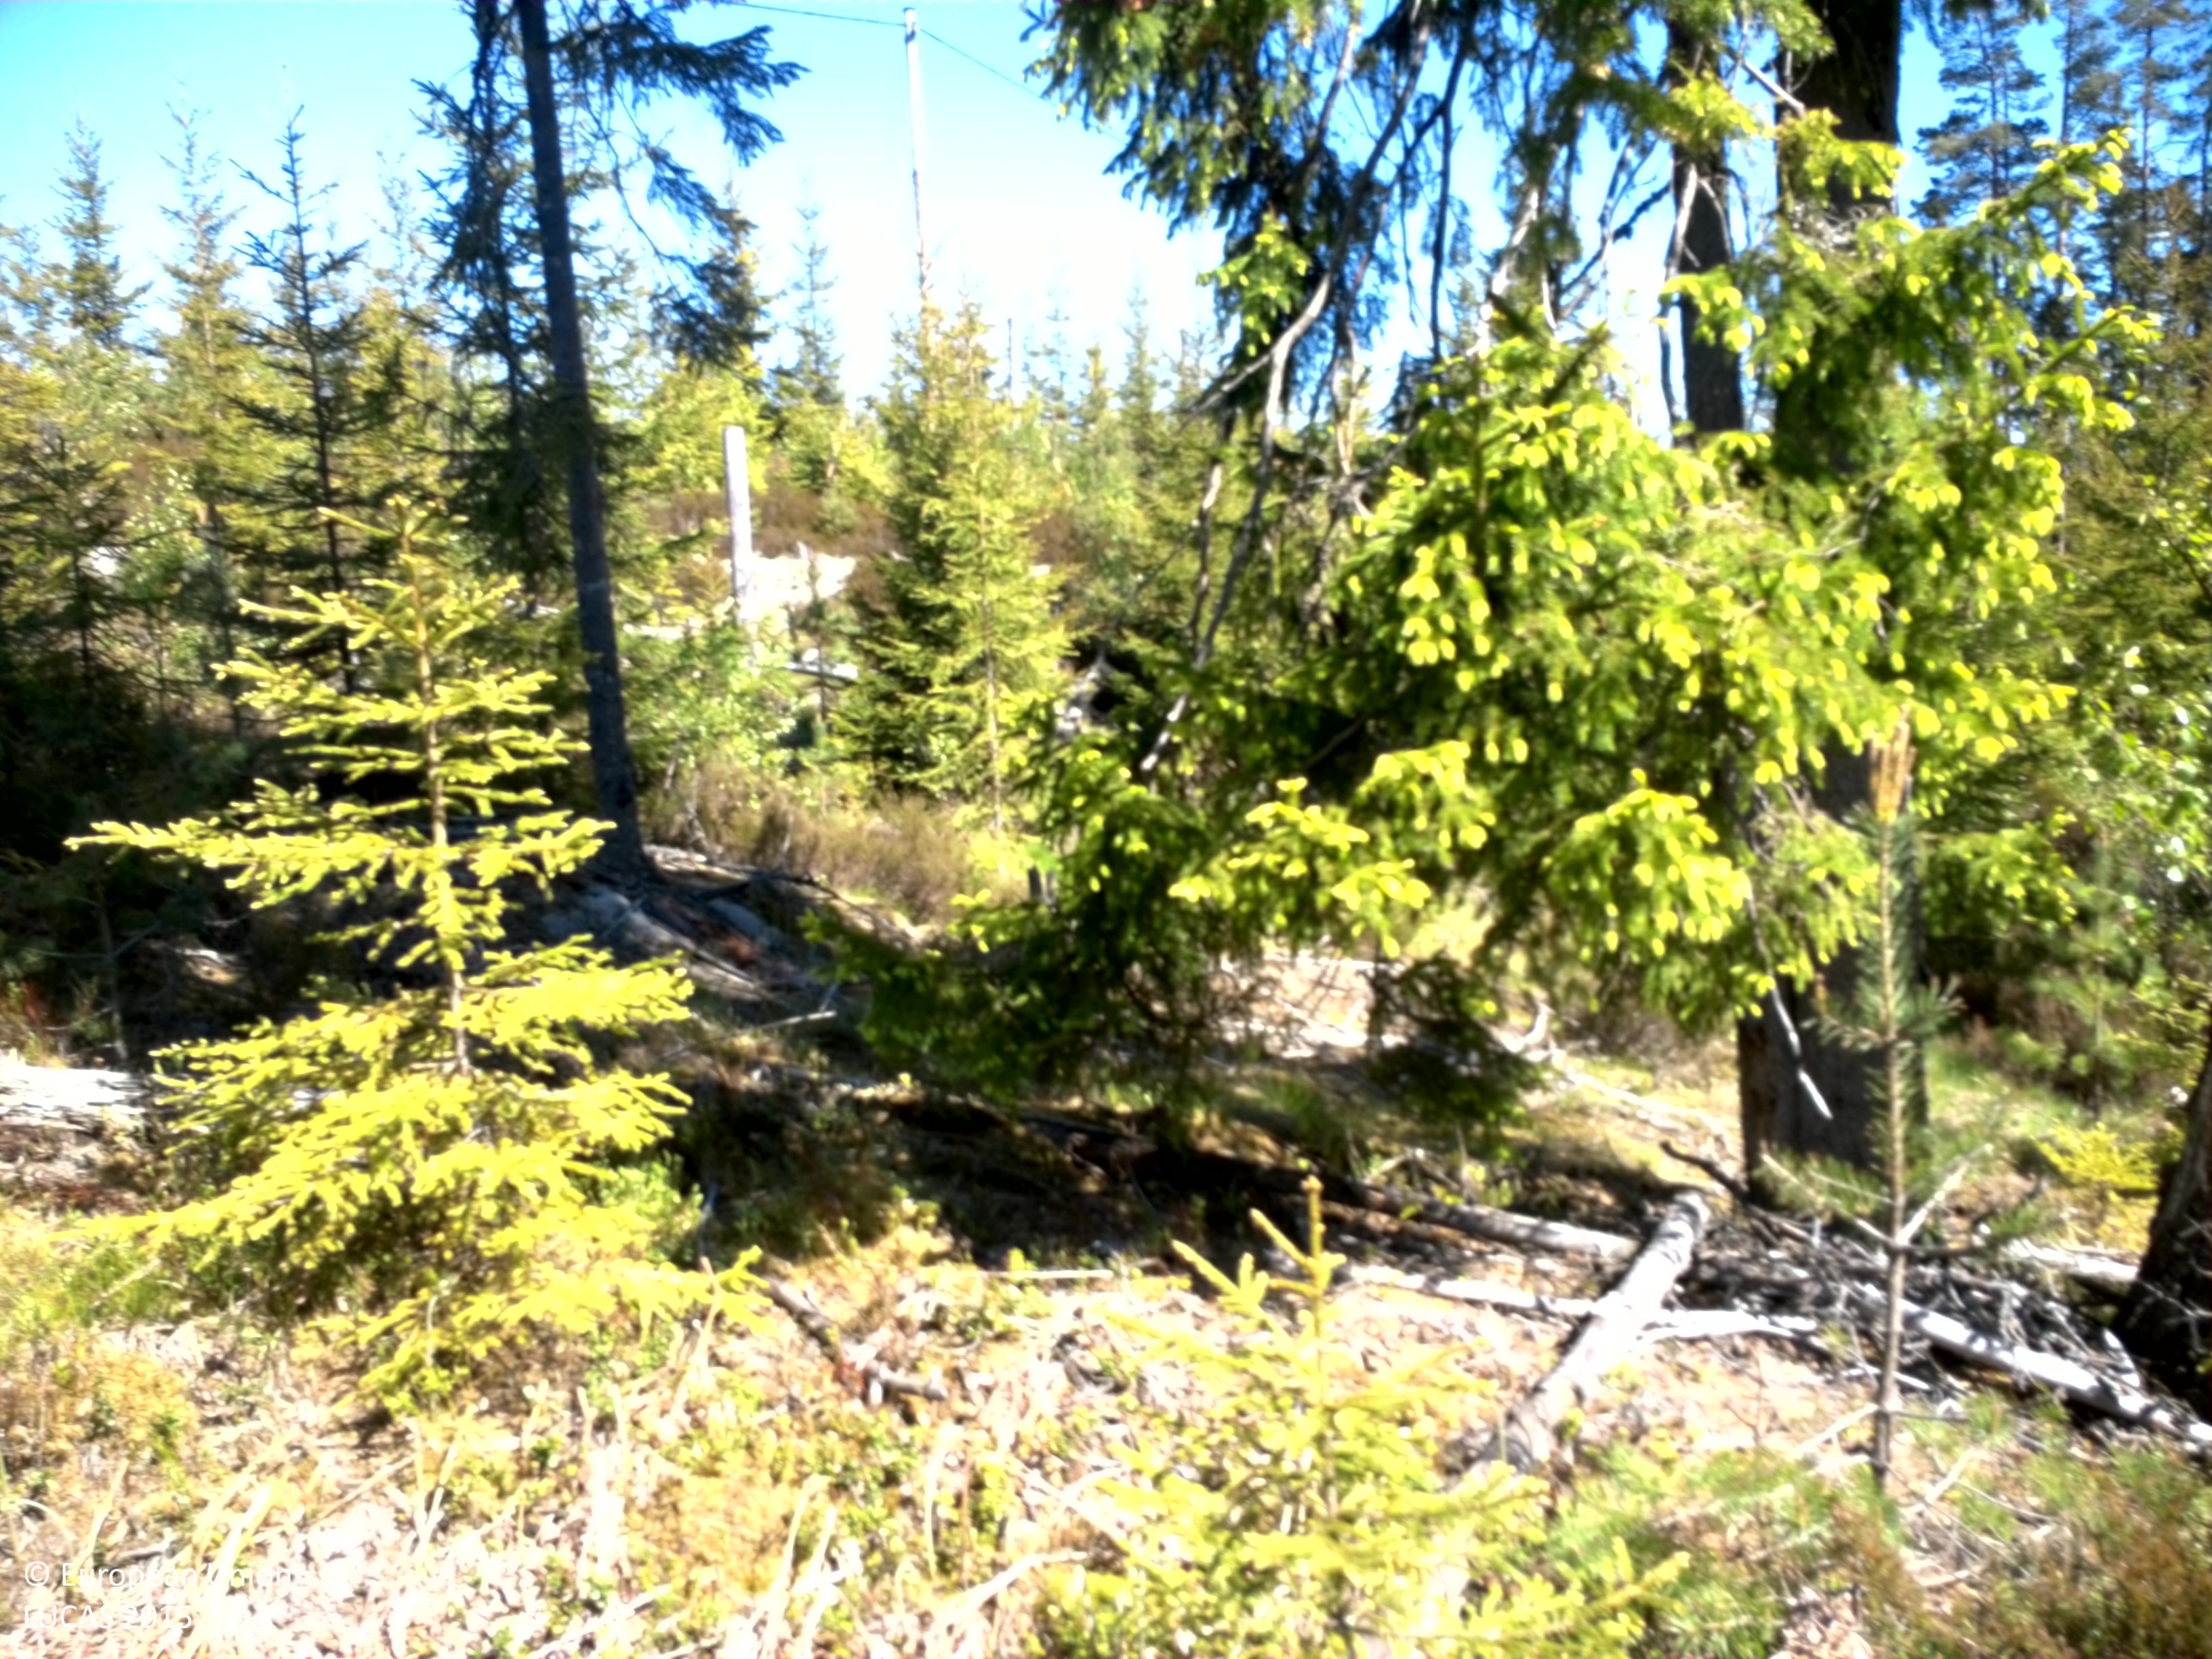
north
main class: Woodland
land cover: Spruce dominated coniferous woodland
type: boreal forest
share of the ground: 50 - 75 %
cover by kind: coniferous forest trees 50 %, shrubs 30 %, lichens and mosses 10 %, broadleaved forest trees 5 %, herbaceous plants 5 %
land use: Forestry
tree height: < 5 m
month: June
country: SE
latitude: 59.4038
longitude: 12.4071
